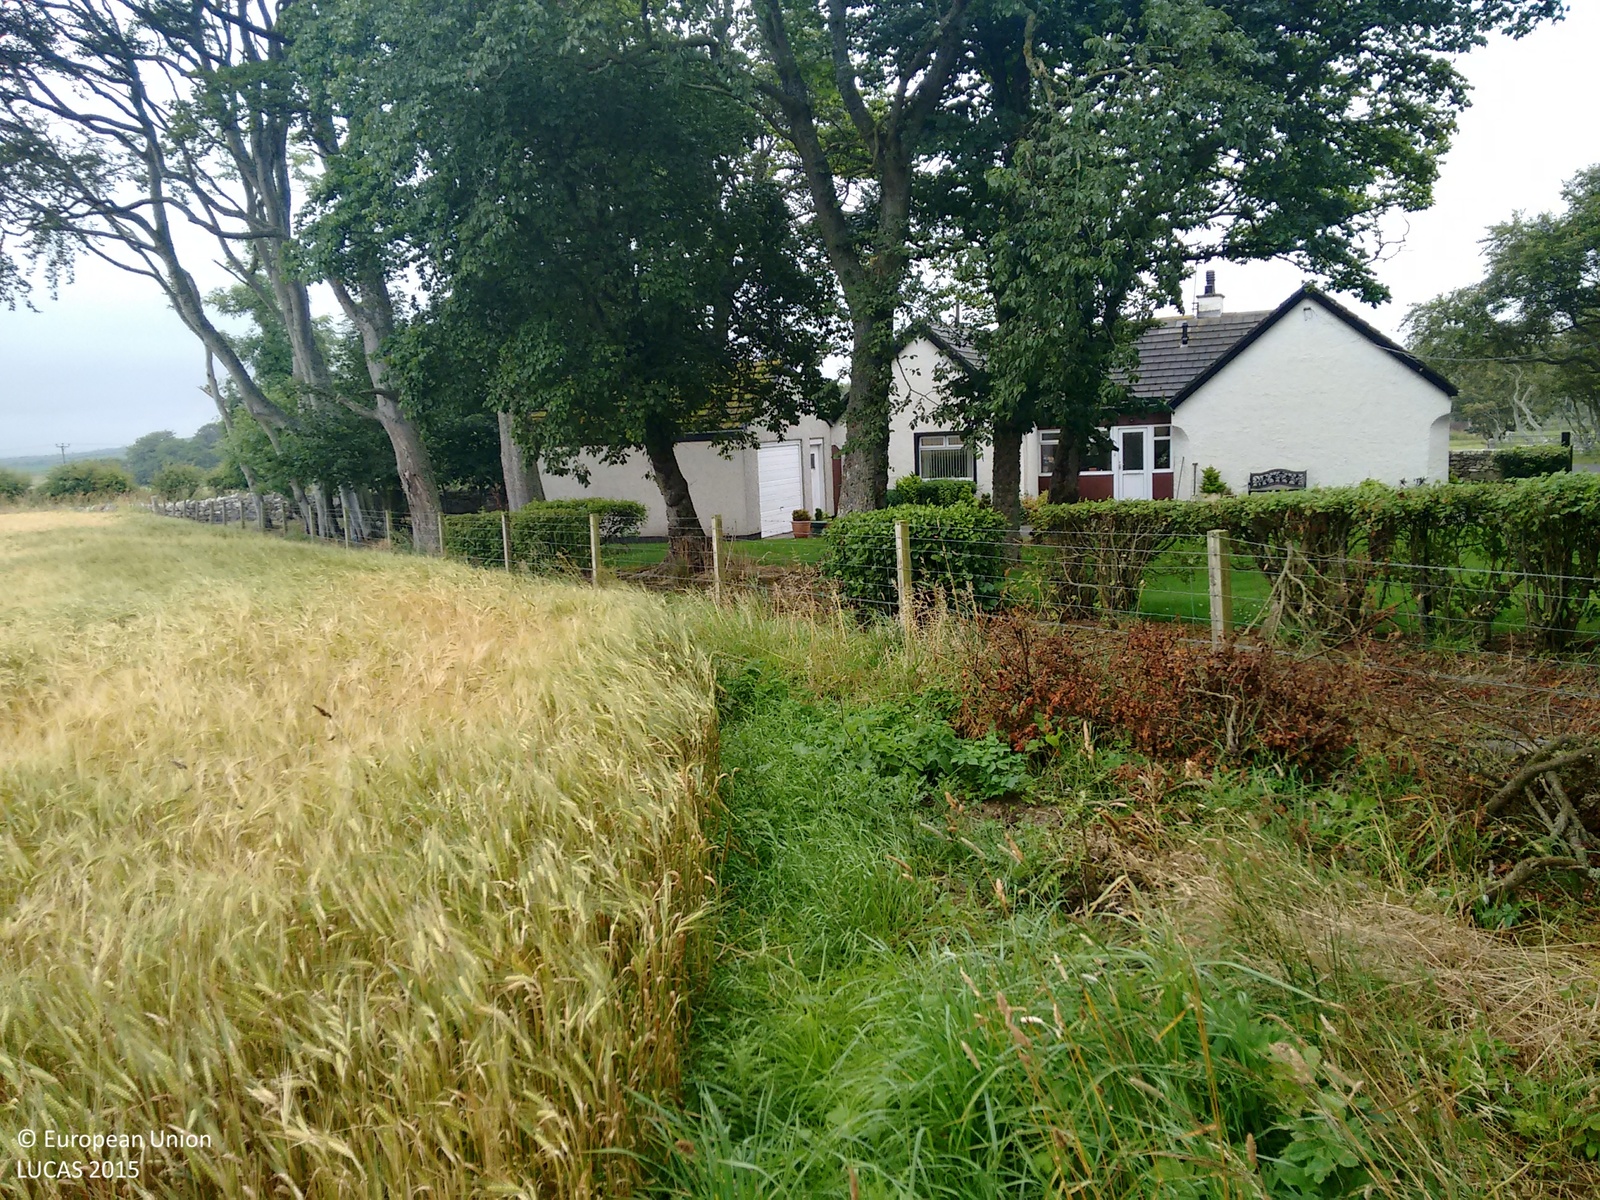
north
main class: Cropland
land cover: Common wheat
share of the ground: > 75 %
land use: Agriculture (excluding fallow land and kitchen gardens)
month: August
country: GB
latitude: 58.4450
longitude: -3.1651
